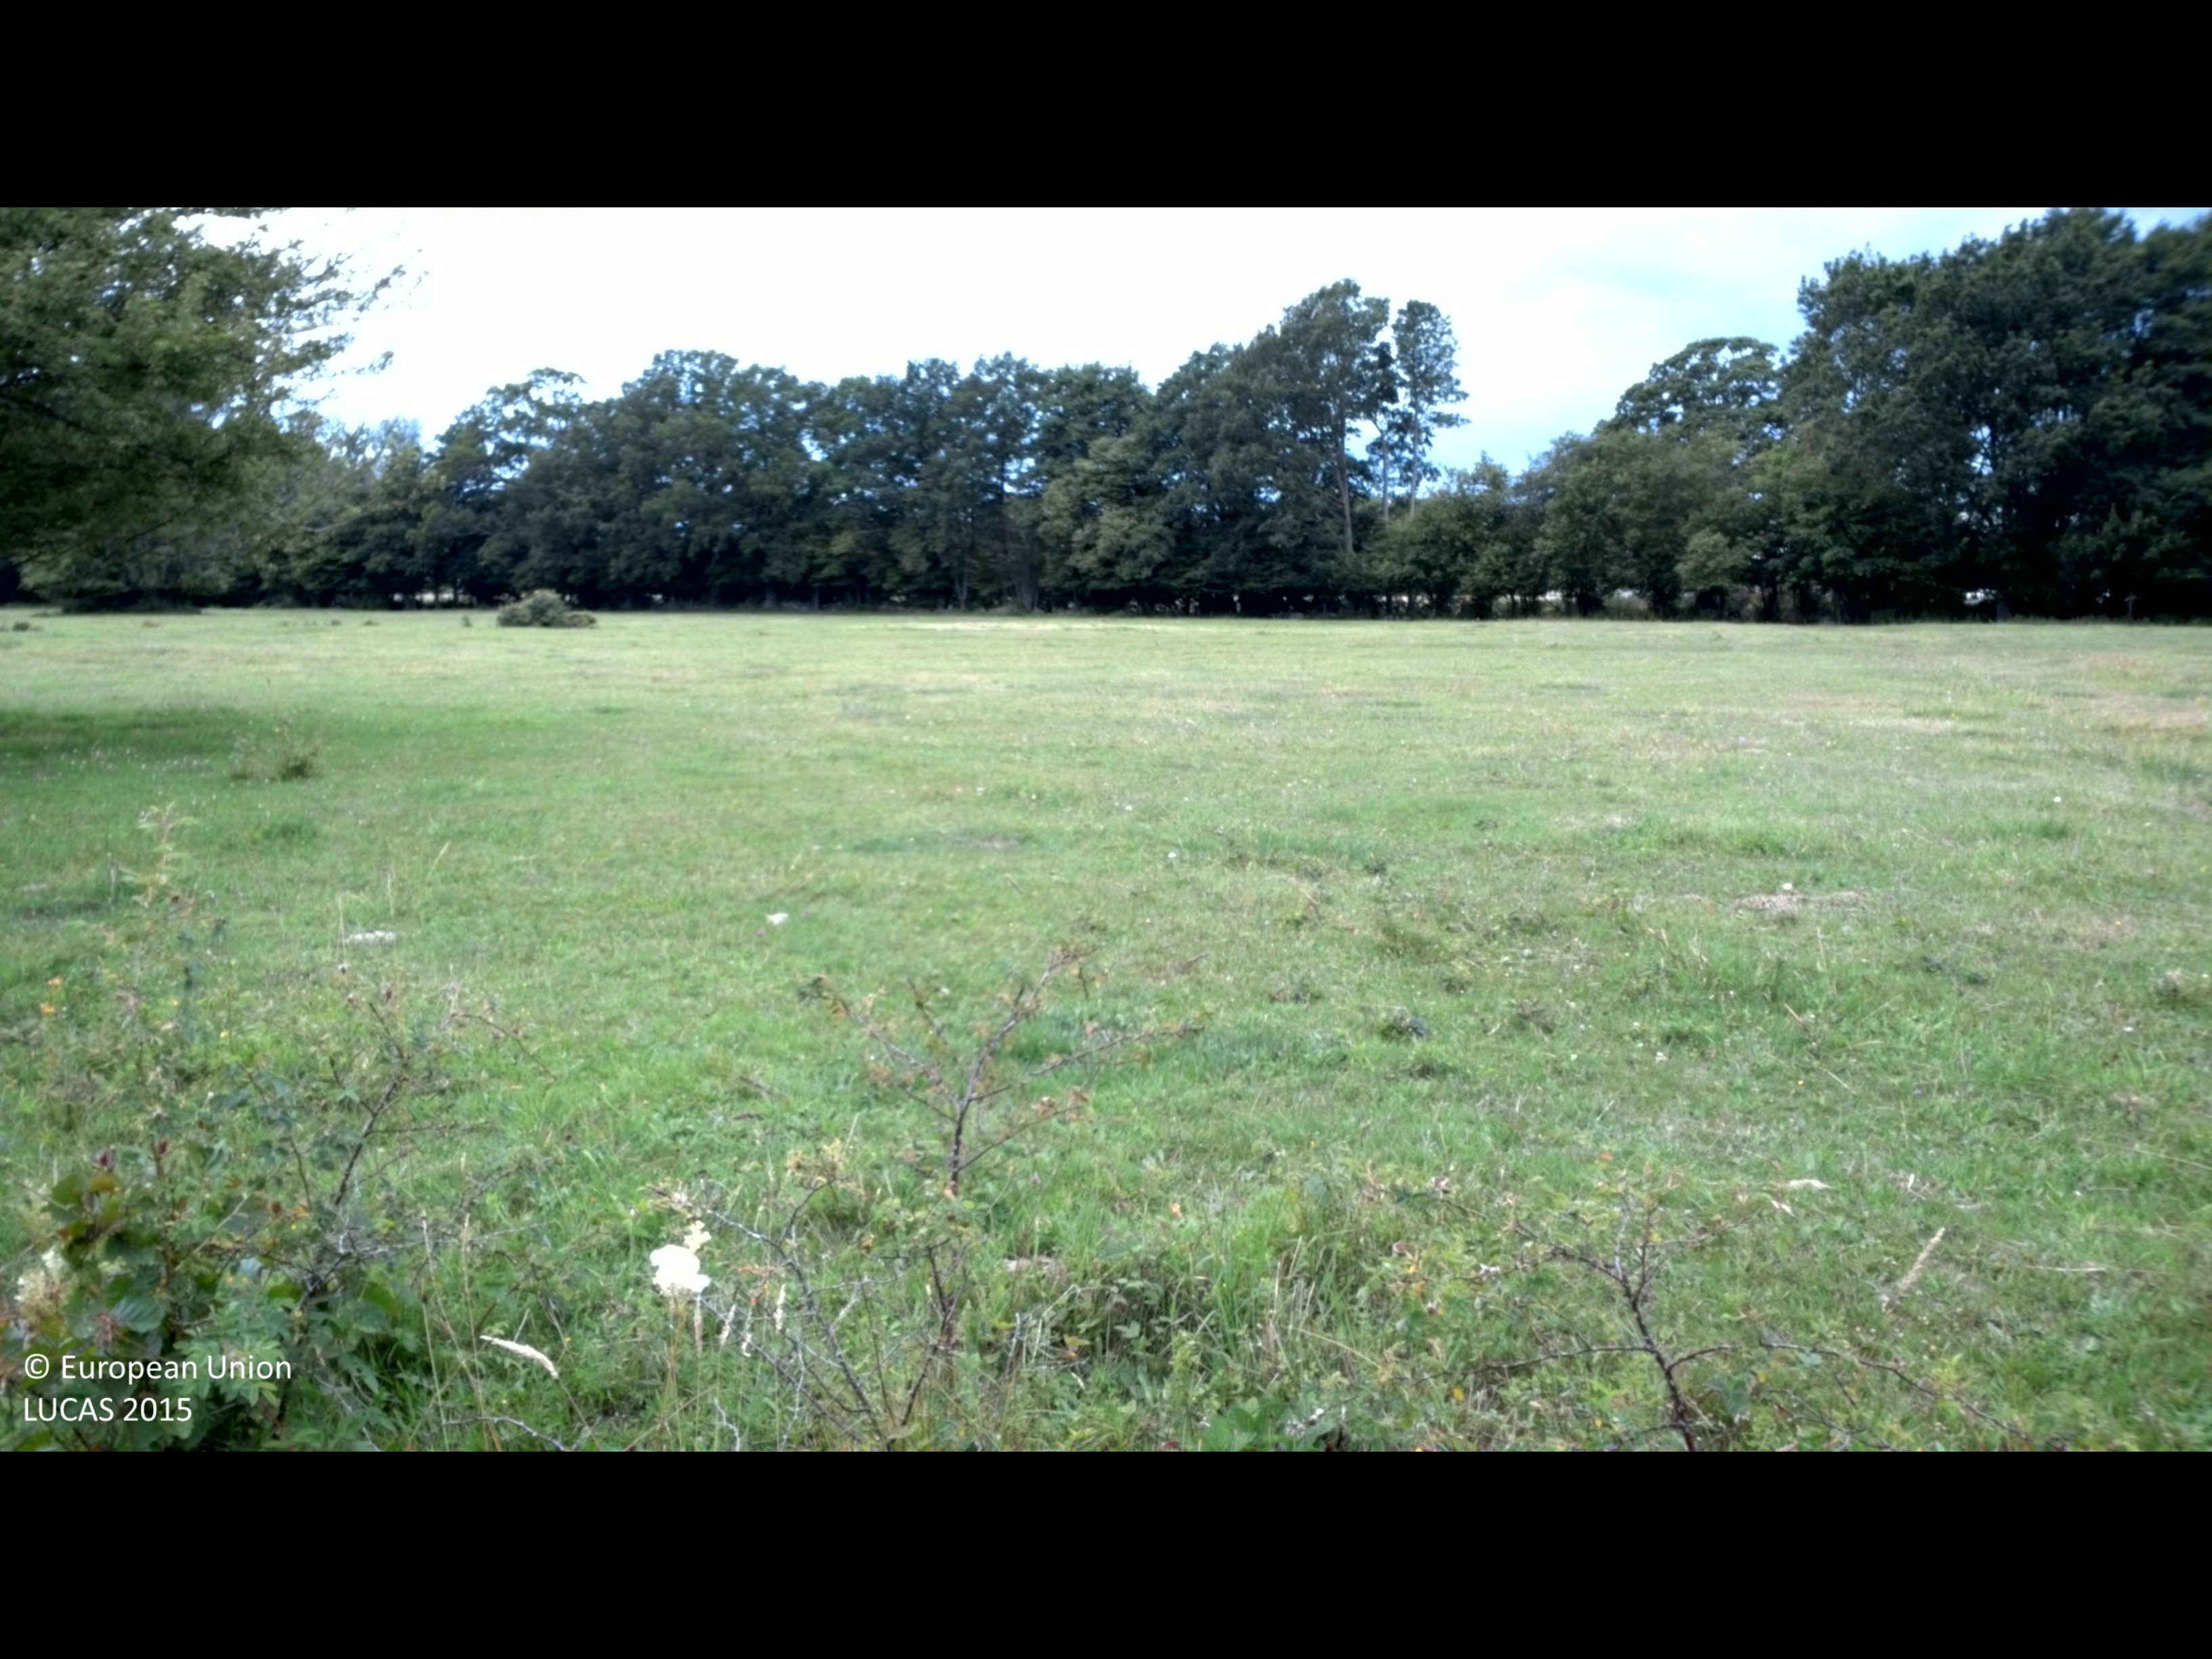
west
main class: Grassland
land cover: Grassland without tree/shrub cover
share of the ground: > 75 %
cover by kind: herbaceous plants 95 %, shrubs 5 %
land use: Agriculture (excluding fallow land and kitchen gardens)
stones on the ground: < 10 %
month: July
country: SE
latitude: 57.1864
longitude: 17.0338
